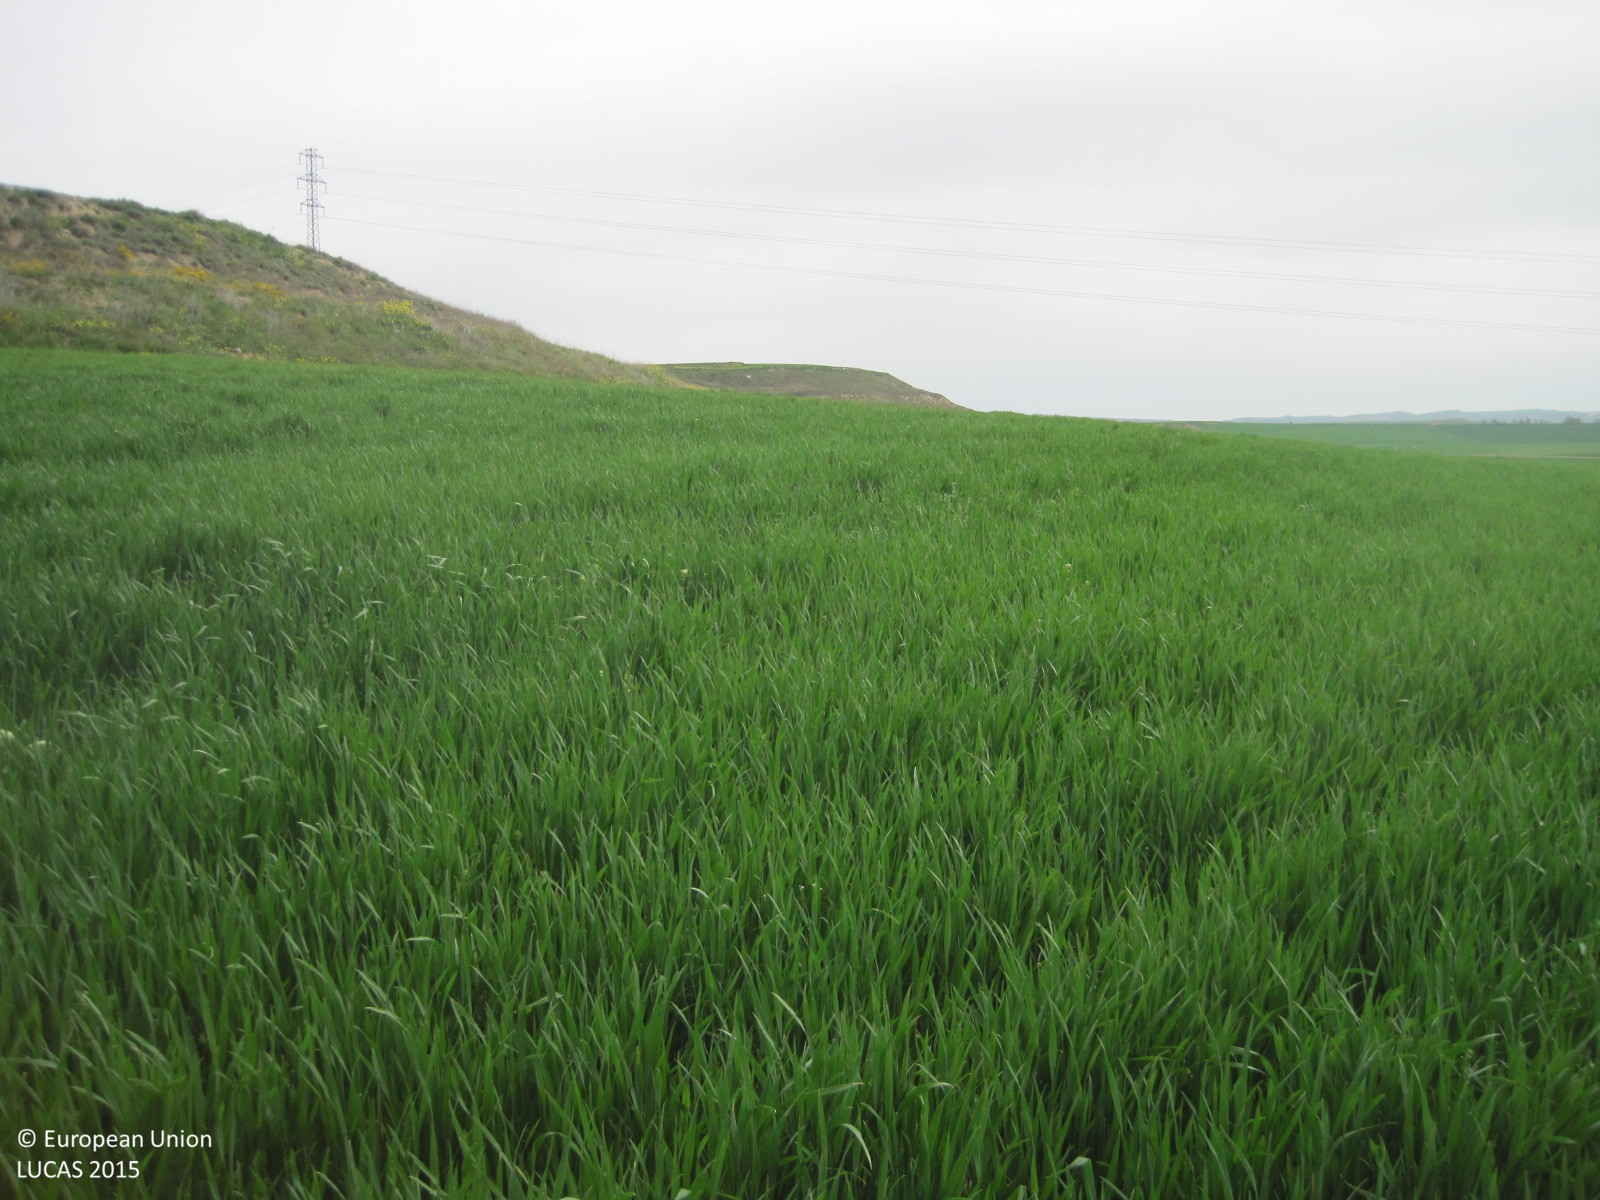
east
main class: Cropland
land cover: Barley
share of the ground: > 75 %
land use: Agriculture (excluding fallow land and kitchen gardens)
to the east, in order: Barley; Shrubland without tree cover; Electric lines; Shrubland without tree cover; Barley
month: April
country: ES
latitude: 42.5510
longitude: -2.2091
